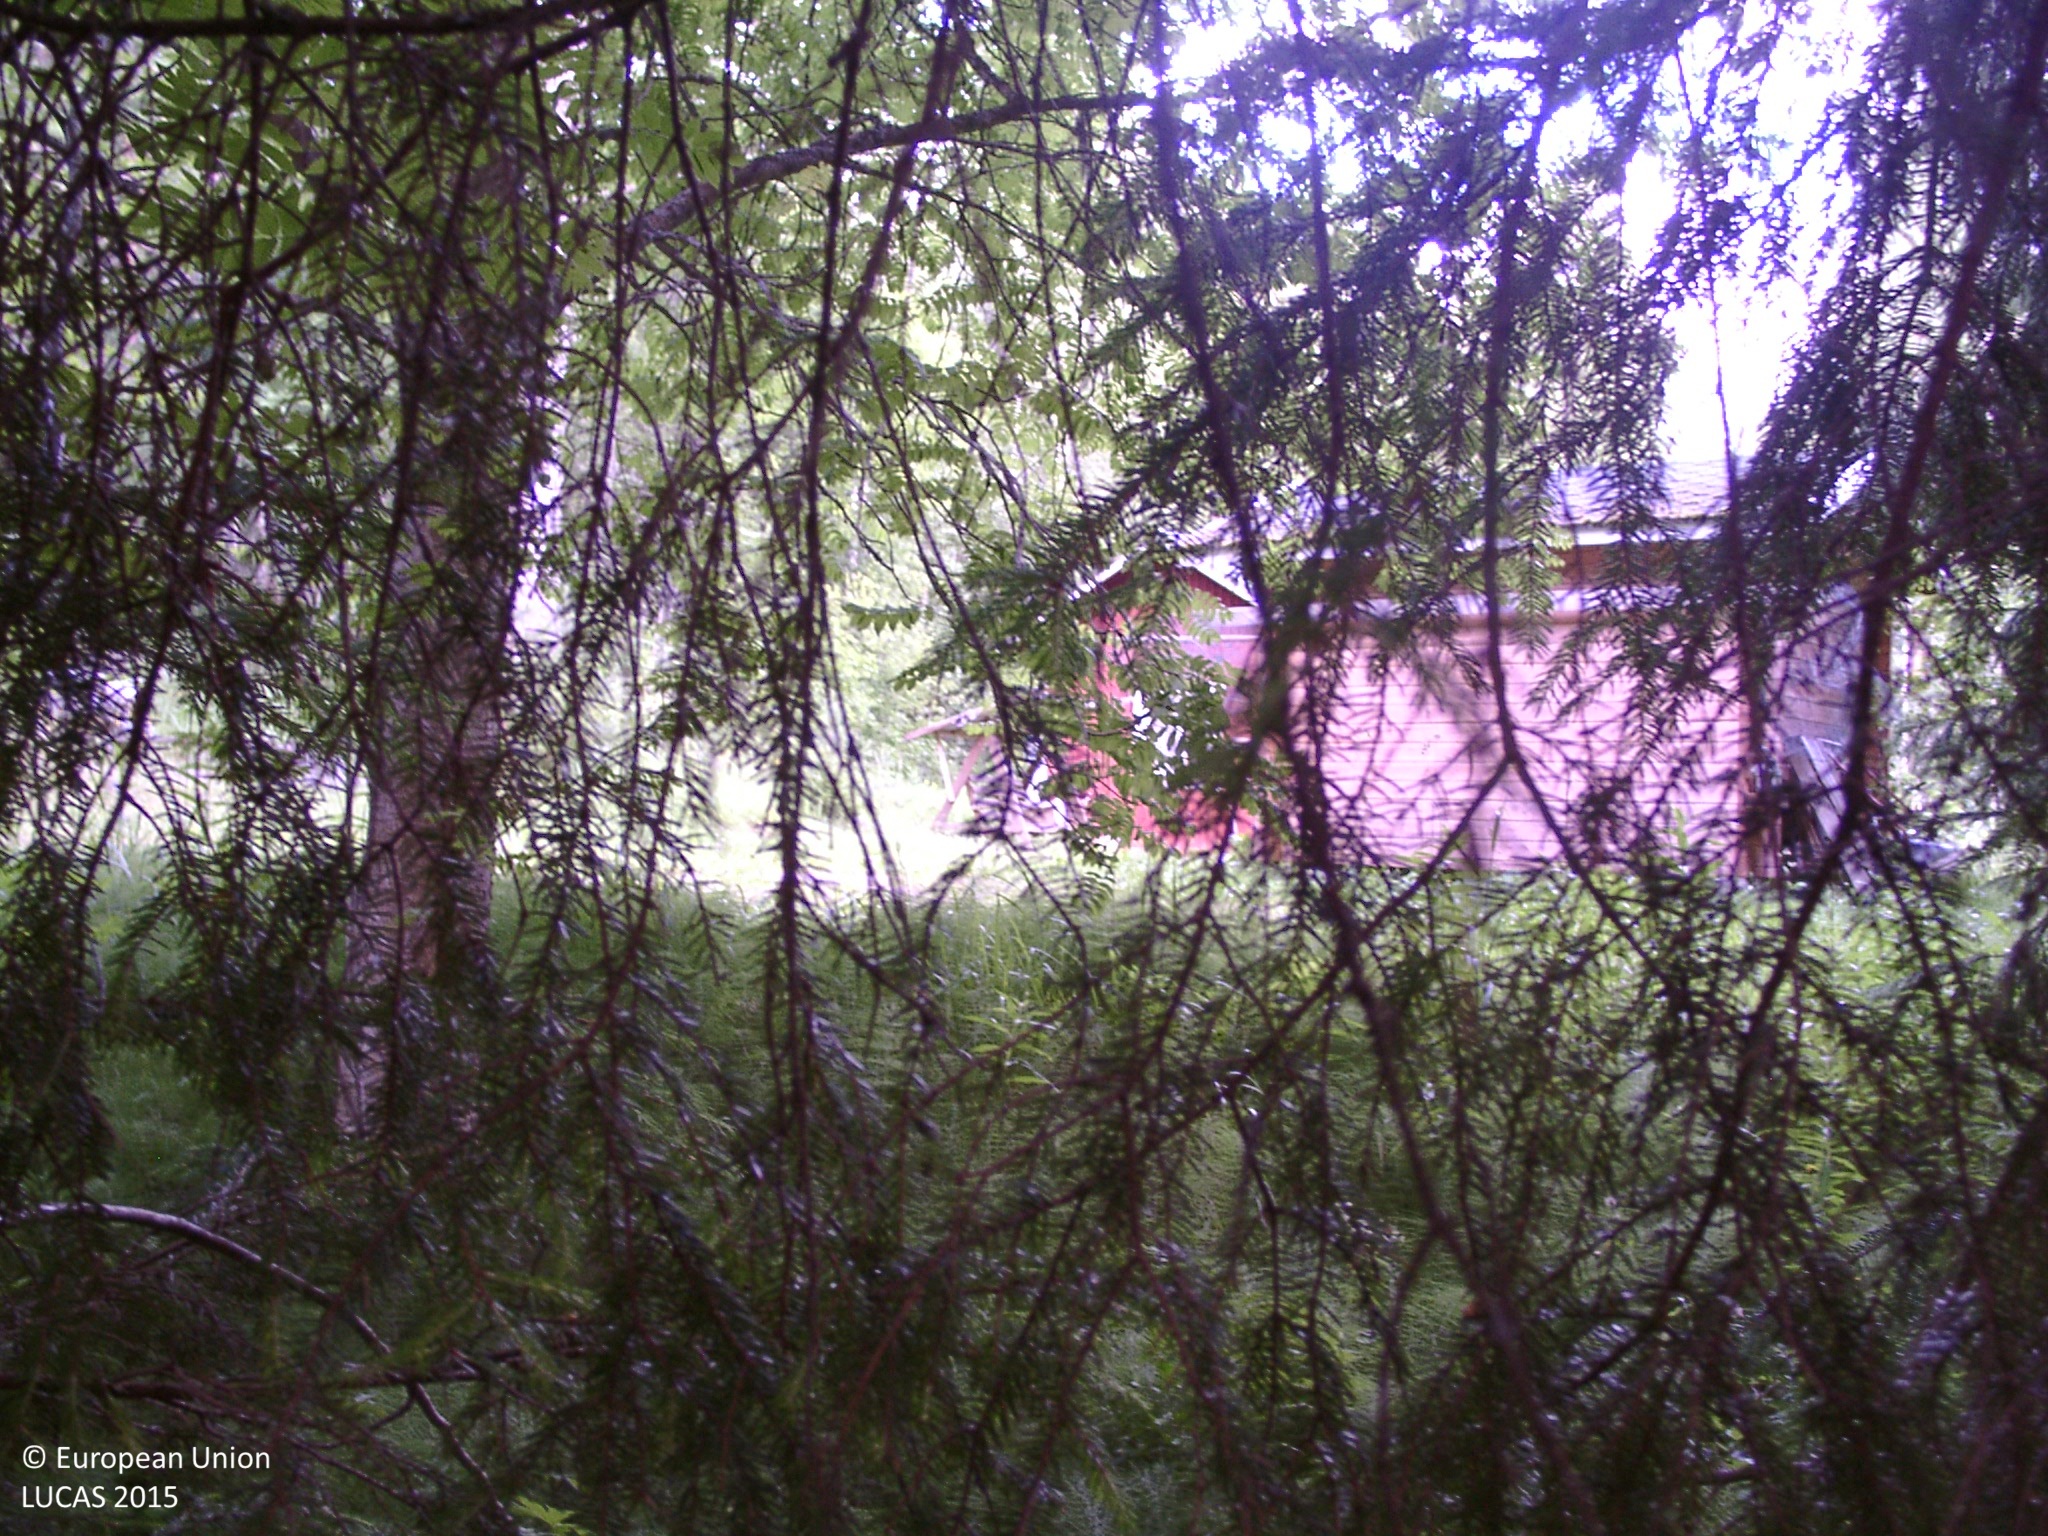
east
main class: Woodland
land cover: Spruce dominated mixed woodland
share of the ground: 50 - 75 %
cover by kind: coniferous forest trees 50 %, herbaceous plants 30 %, broadleaved forest trees 20 %
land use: Semi-natural and natural areas not in use
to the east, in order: Spruce dominated mixed woodland; Artificial constructions in urban areas; Broadleaved woodland; Other mixed woodland; Shrubland with sparse tree cover; Ponds and wetlands; Grassland with sparse tree/shrub cover; Spruce dominated mixed woodland
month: July
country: FI
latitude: 61.6944
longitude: 24.9468
